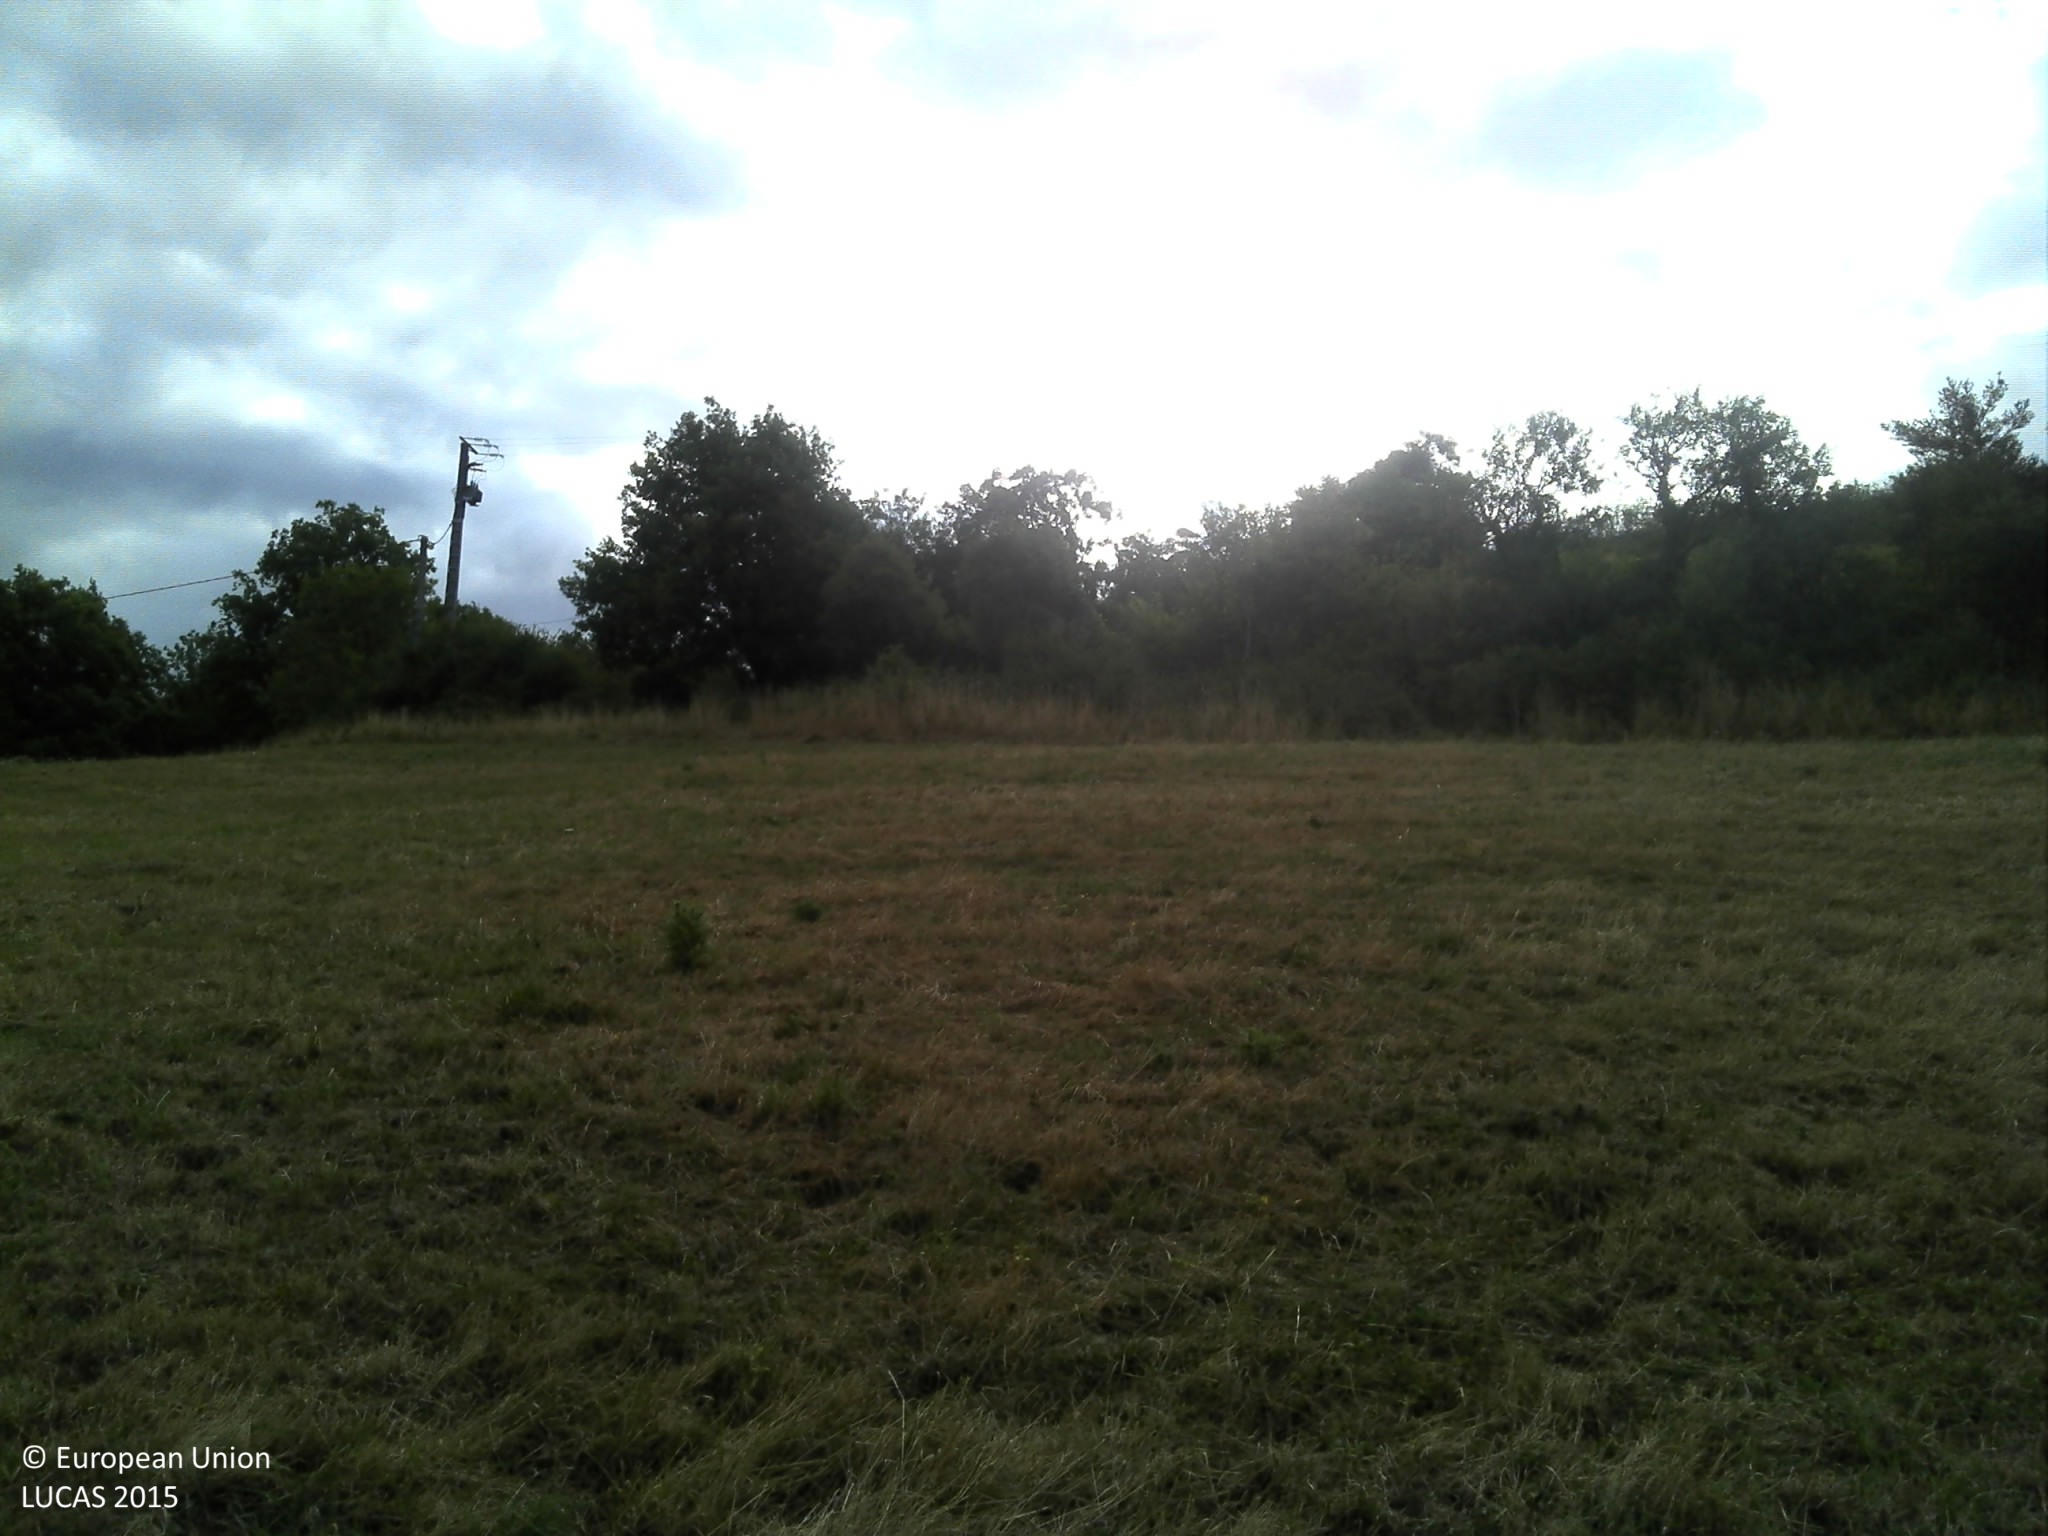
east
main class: Grassland
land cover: Grassland without tree/shrub cover
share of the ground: > 75 %
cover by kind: herbaceous plants 100 %
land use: Agriculture (excluding fallow land and kitchen gardens)
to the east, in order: Grassland without tree/shrub cover; Fences; Abandoned hedges; Electric lines; Lines of trees; Grass margins; Ditches and canals; Grass margins; Paved roads, cycling and walking lanes; Grass margins; Ditches and canals; Abandoned hedges; Fences; Grassland without tree/shrub cover; Fences; Broadleaved woodland; Fences; Broadleaved woodland
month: July
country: FR
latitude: 45.8821
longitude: 4.1136
